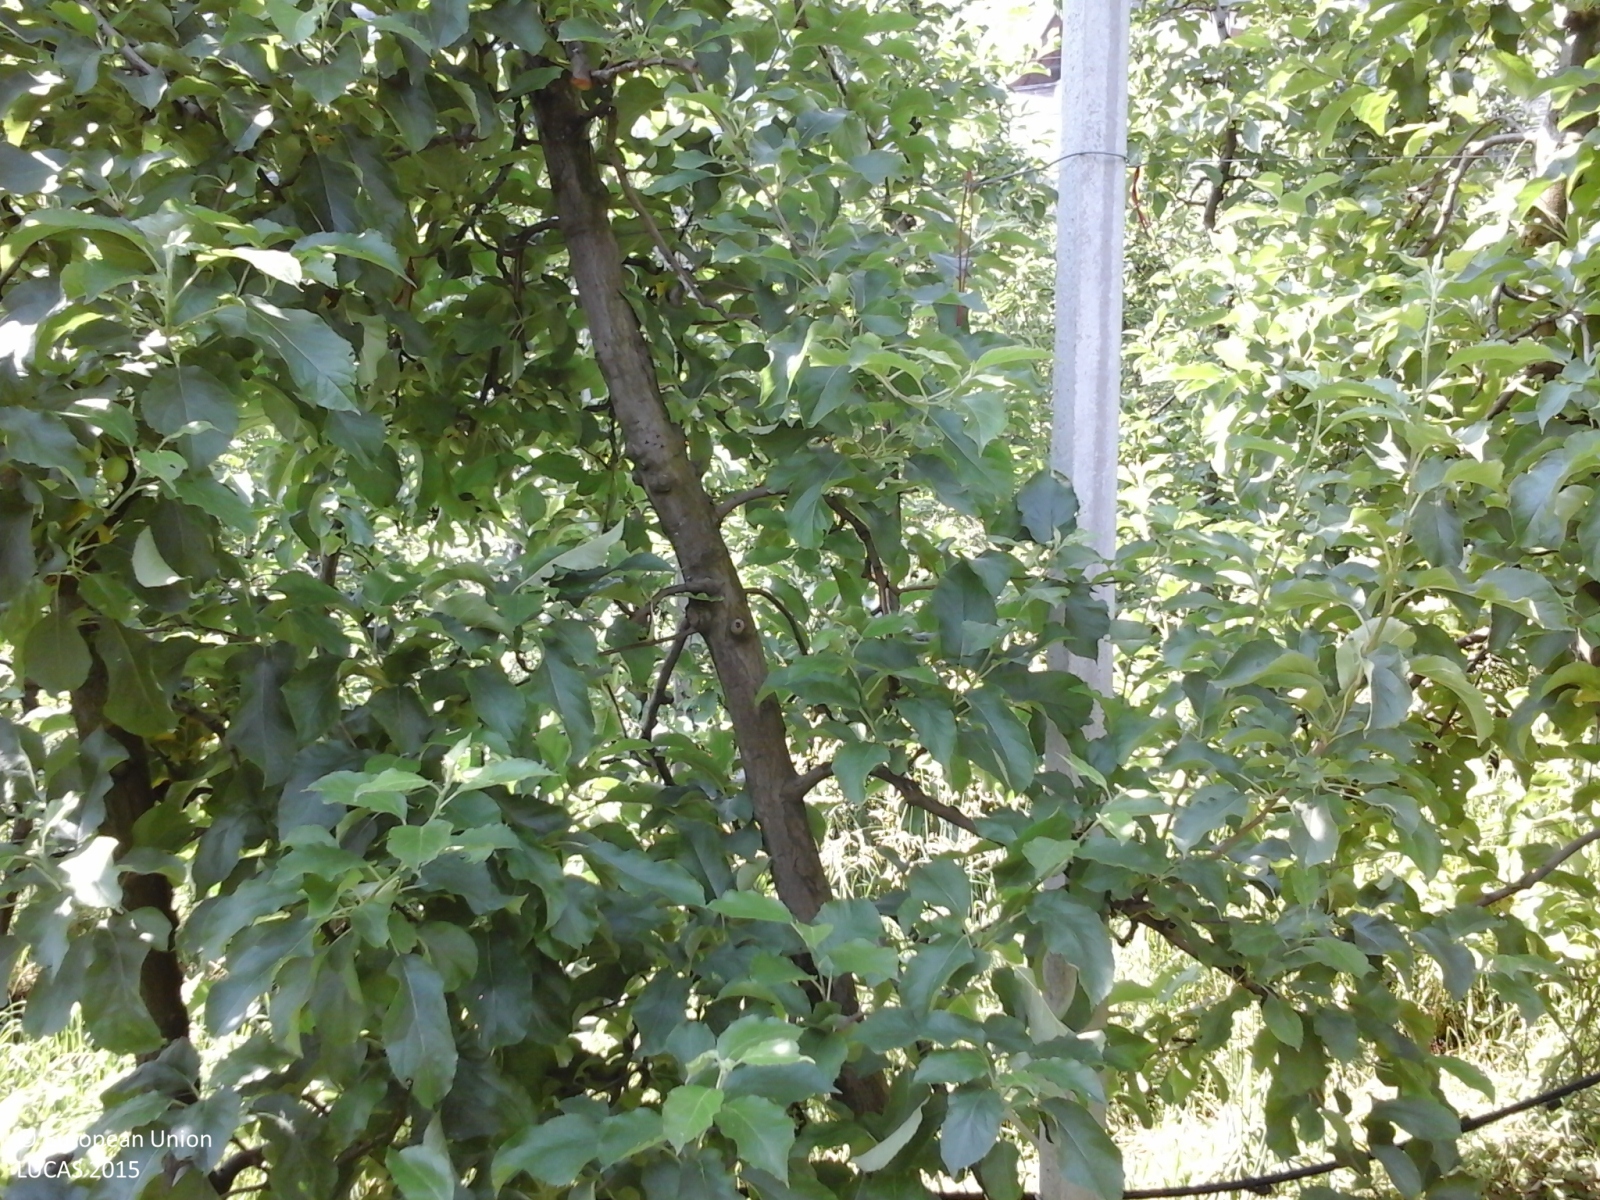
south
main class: Cropland
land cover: Apple fruit
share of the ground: > 75 %
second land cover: Grassland without tree/shrub cover
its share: > 75 %
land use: Agriculture (excluding fallow land and kitchen gardens)
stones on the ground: < 10 %
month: May
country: IT
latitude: 46.6154
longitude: 11.1347
